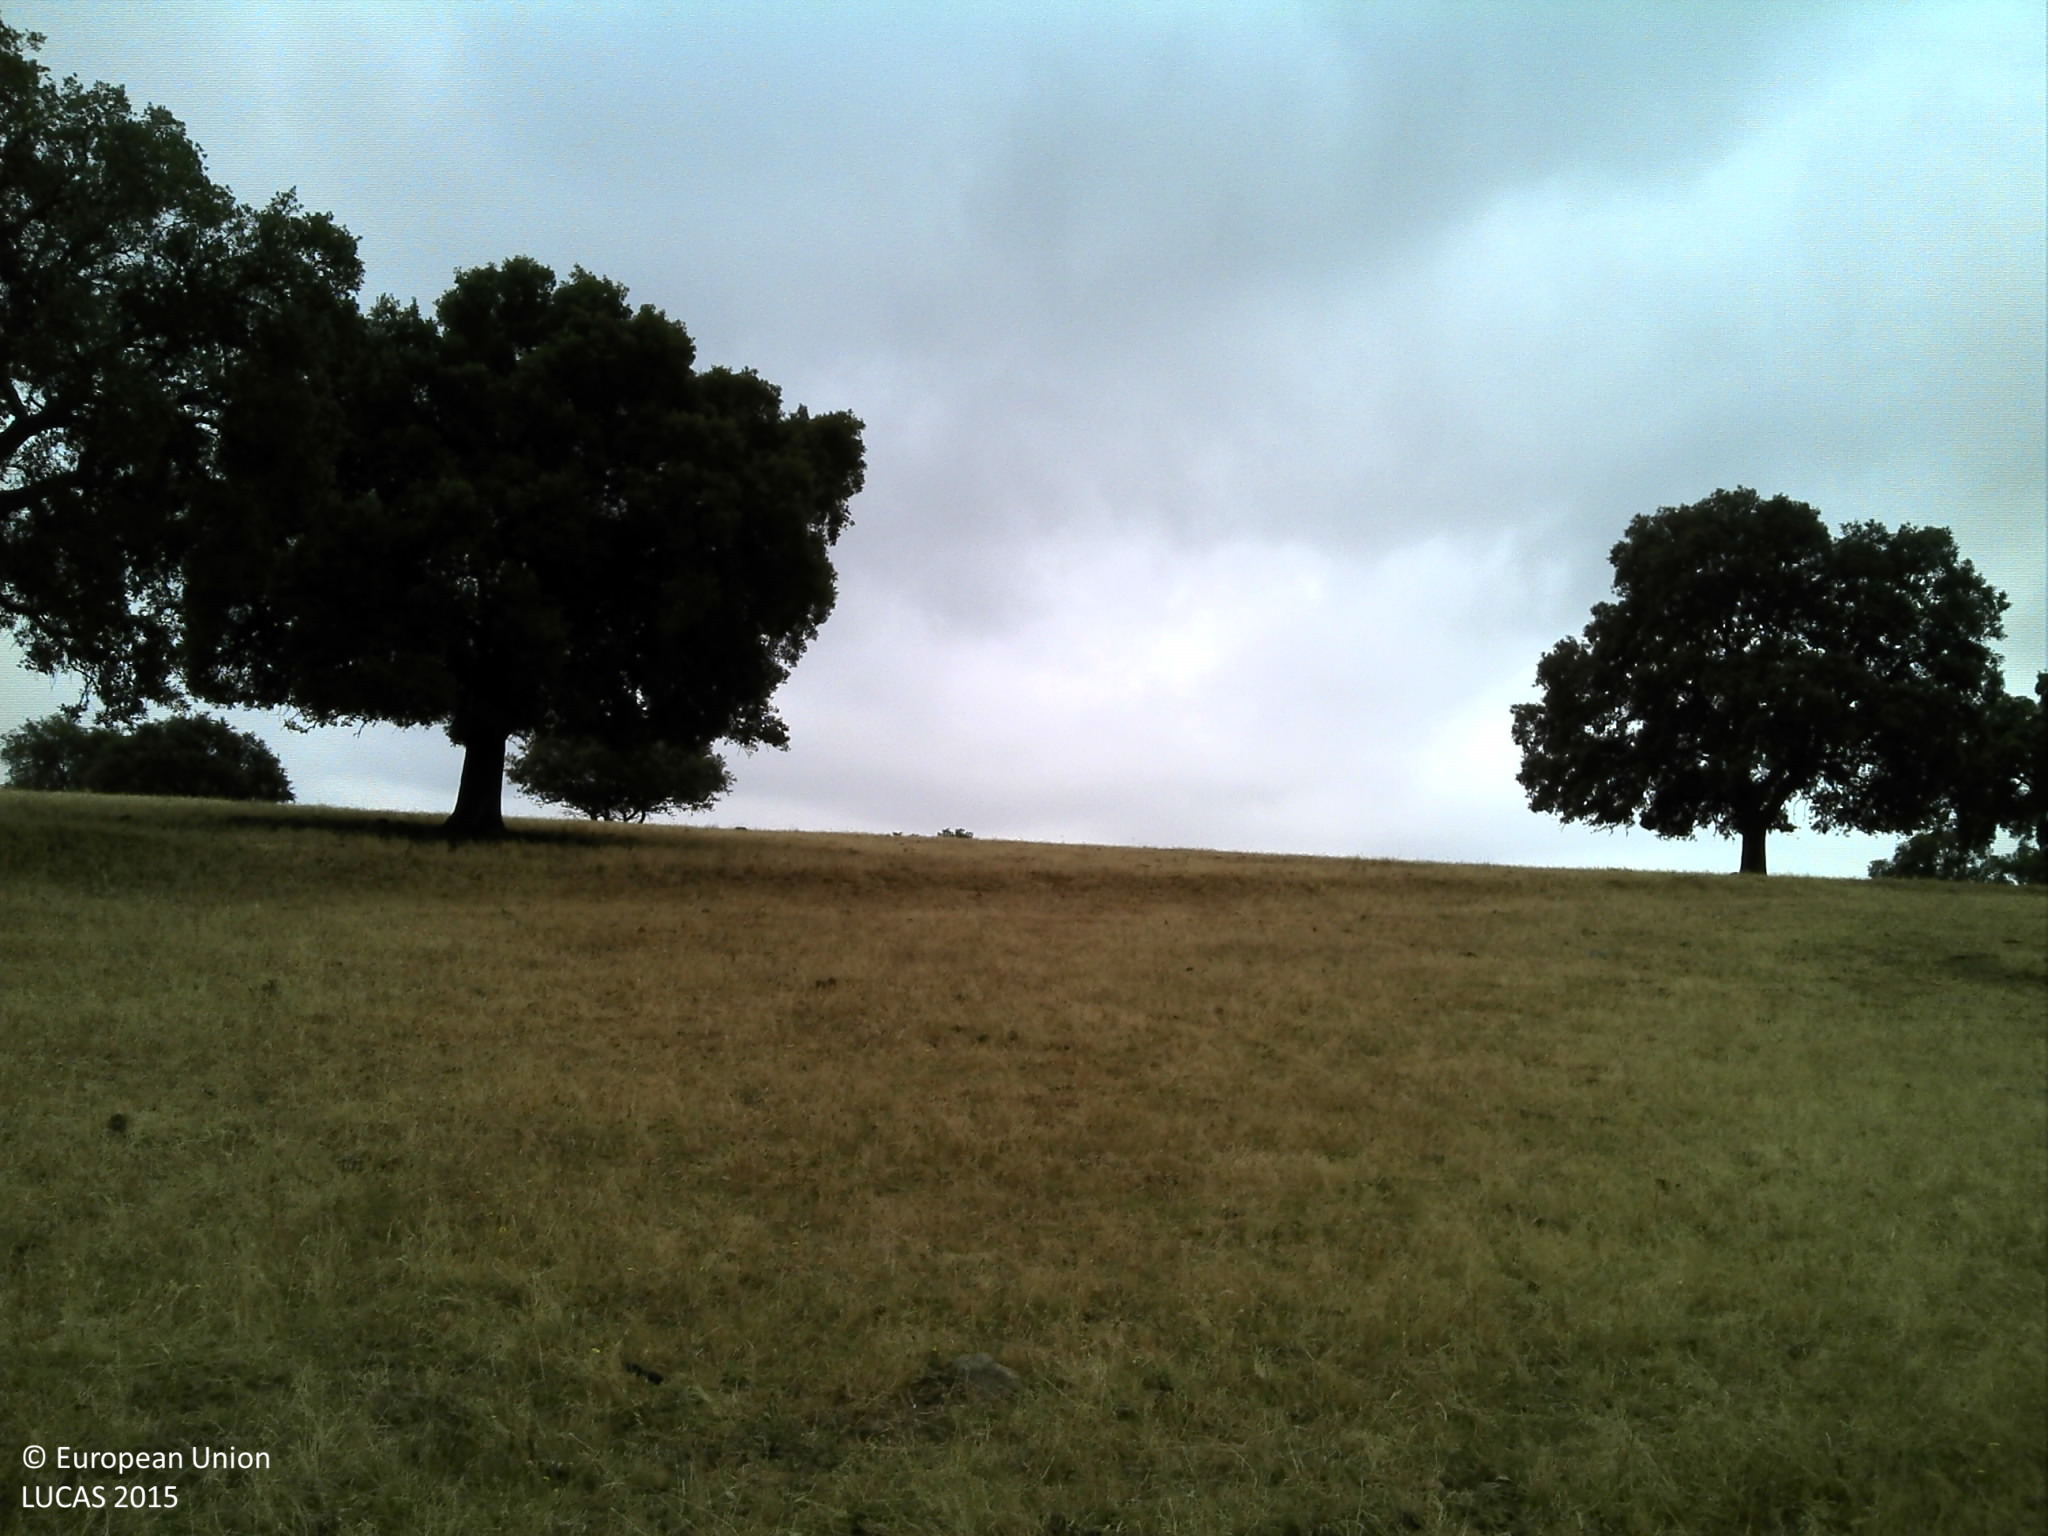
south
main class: Grassland
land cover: Spontaneously vegetated surfaces
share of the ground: 10 - 25 %
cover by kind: unconsolidated bare surface 75 %, herbaceous plants 25 %
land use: Agriculture (excluding fallow land and kitchen gardens)
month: June
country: PT
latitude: 38.3351
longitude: -7.9633
